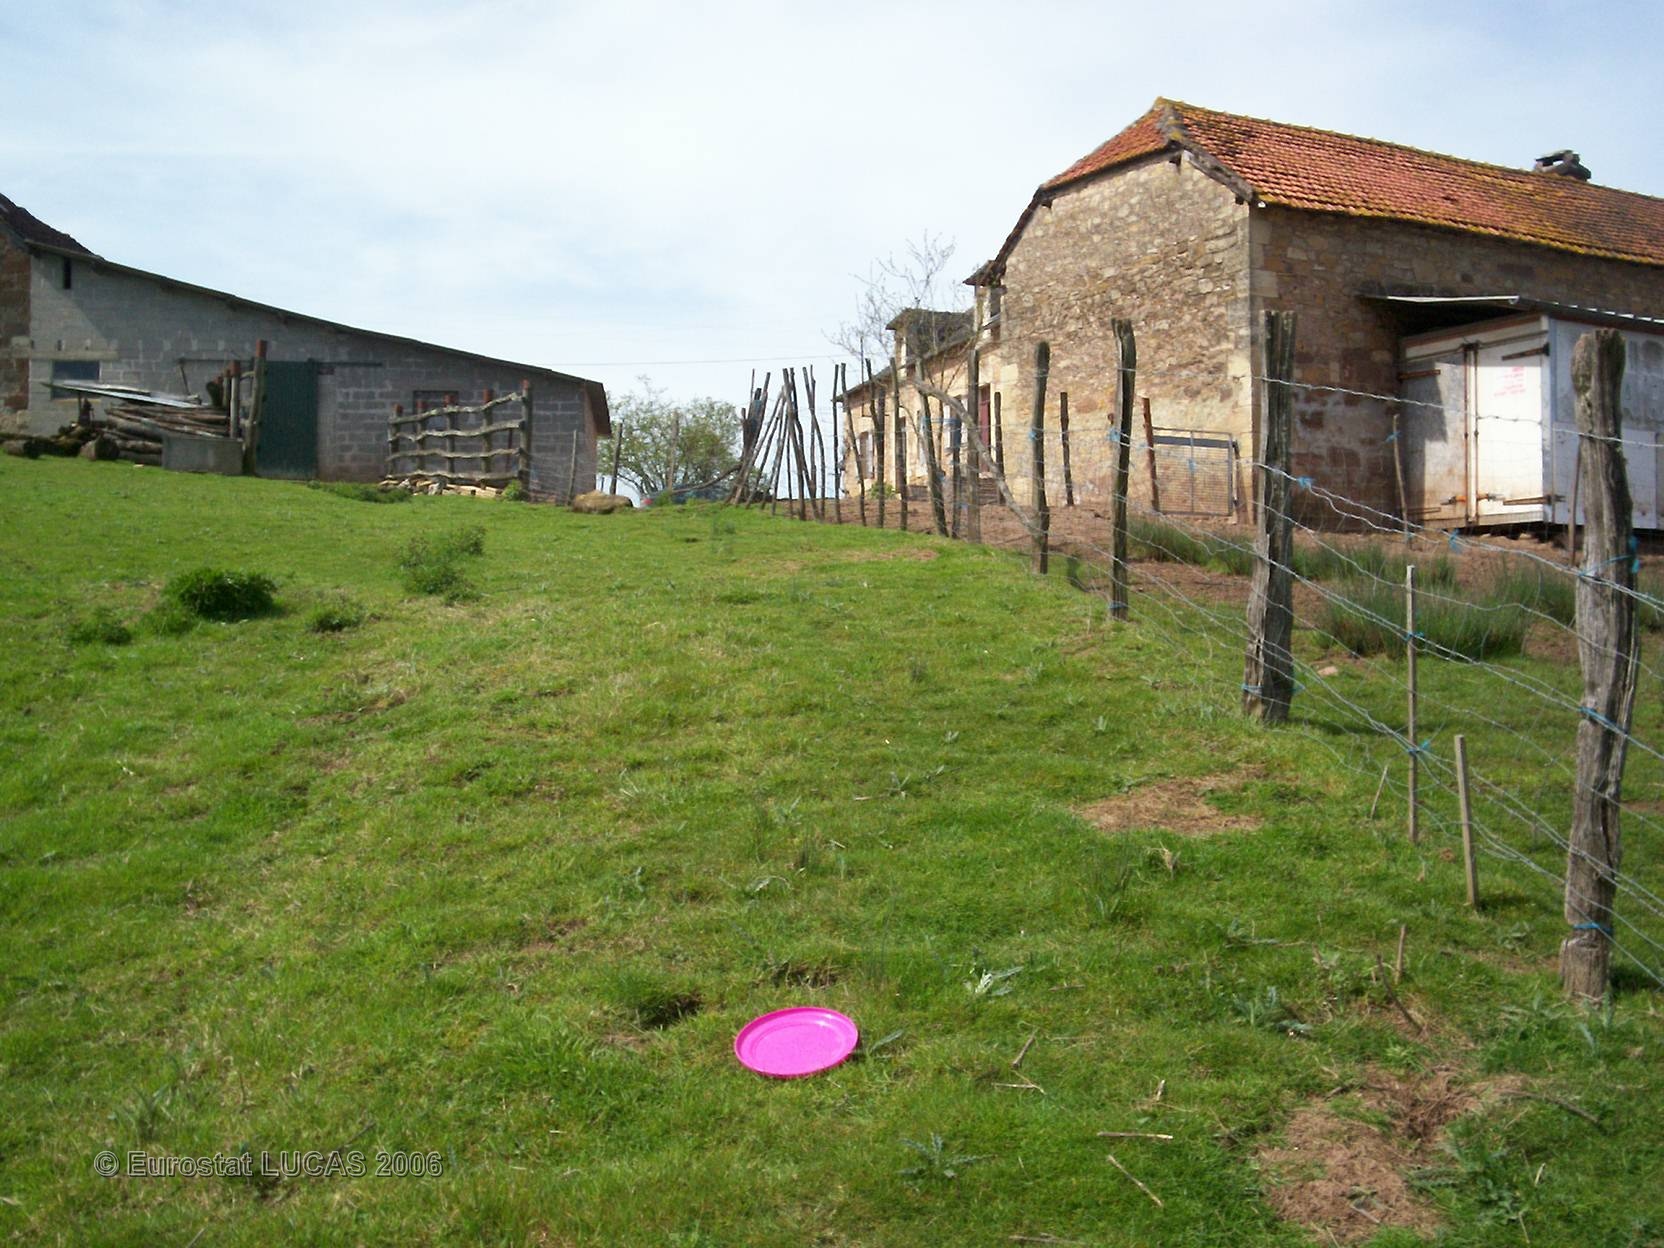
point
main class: Grassland
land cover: Grassland without tree/shrub cover
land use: Agriculture (excluding fallow land and kitchen gardens)
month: April
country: FR
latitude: 45.2169
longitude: 1.2964
